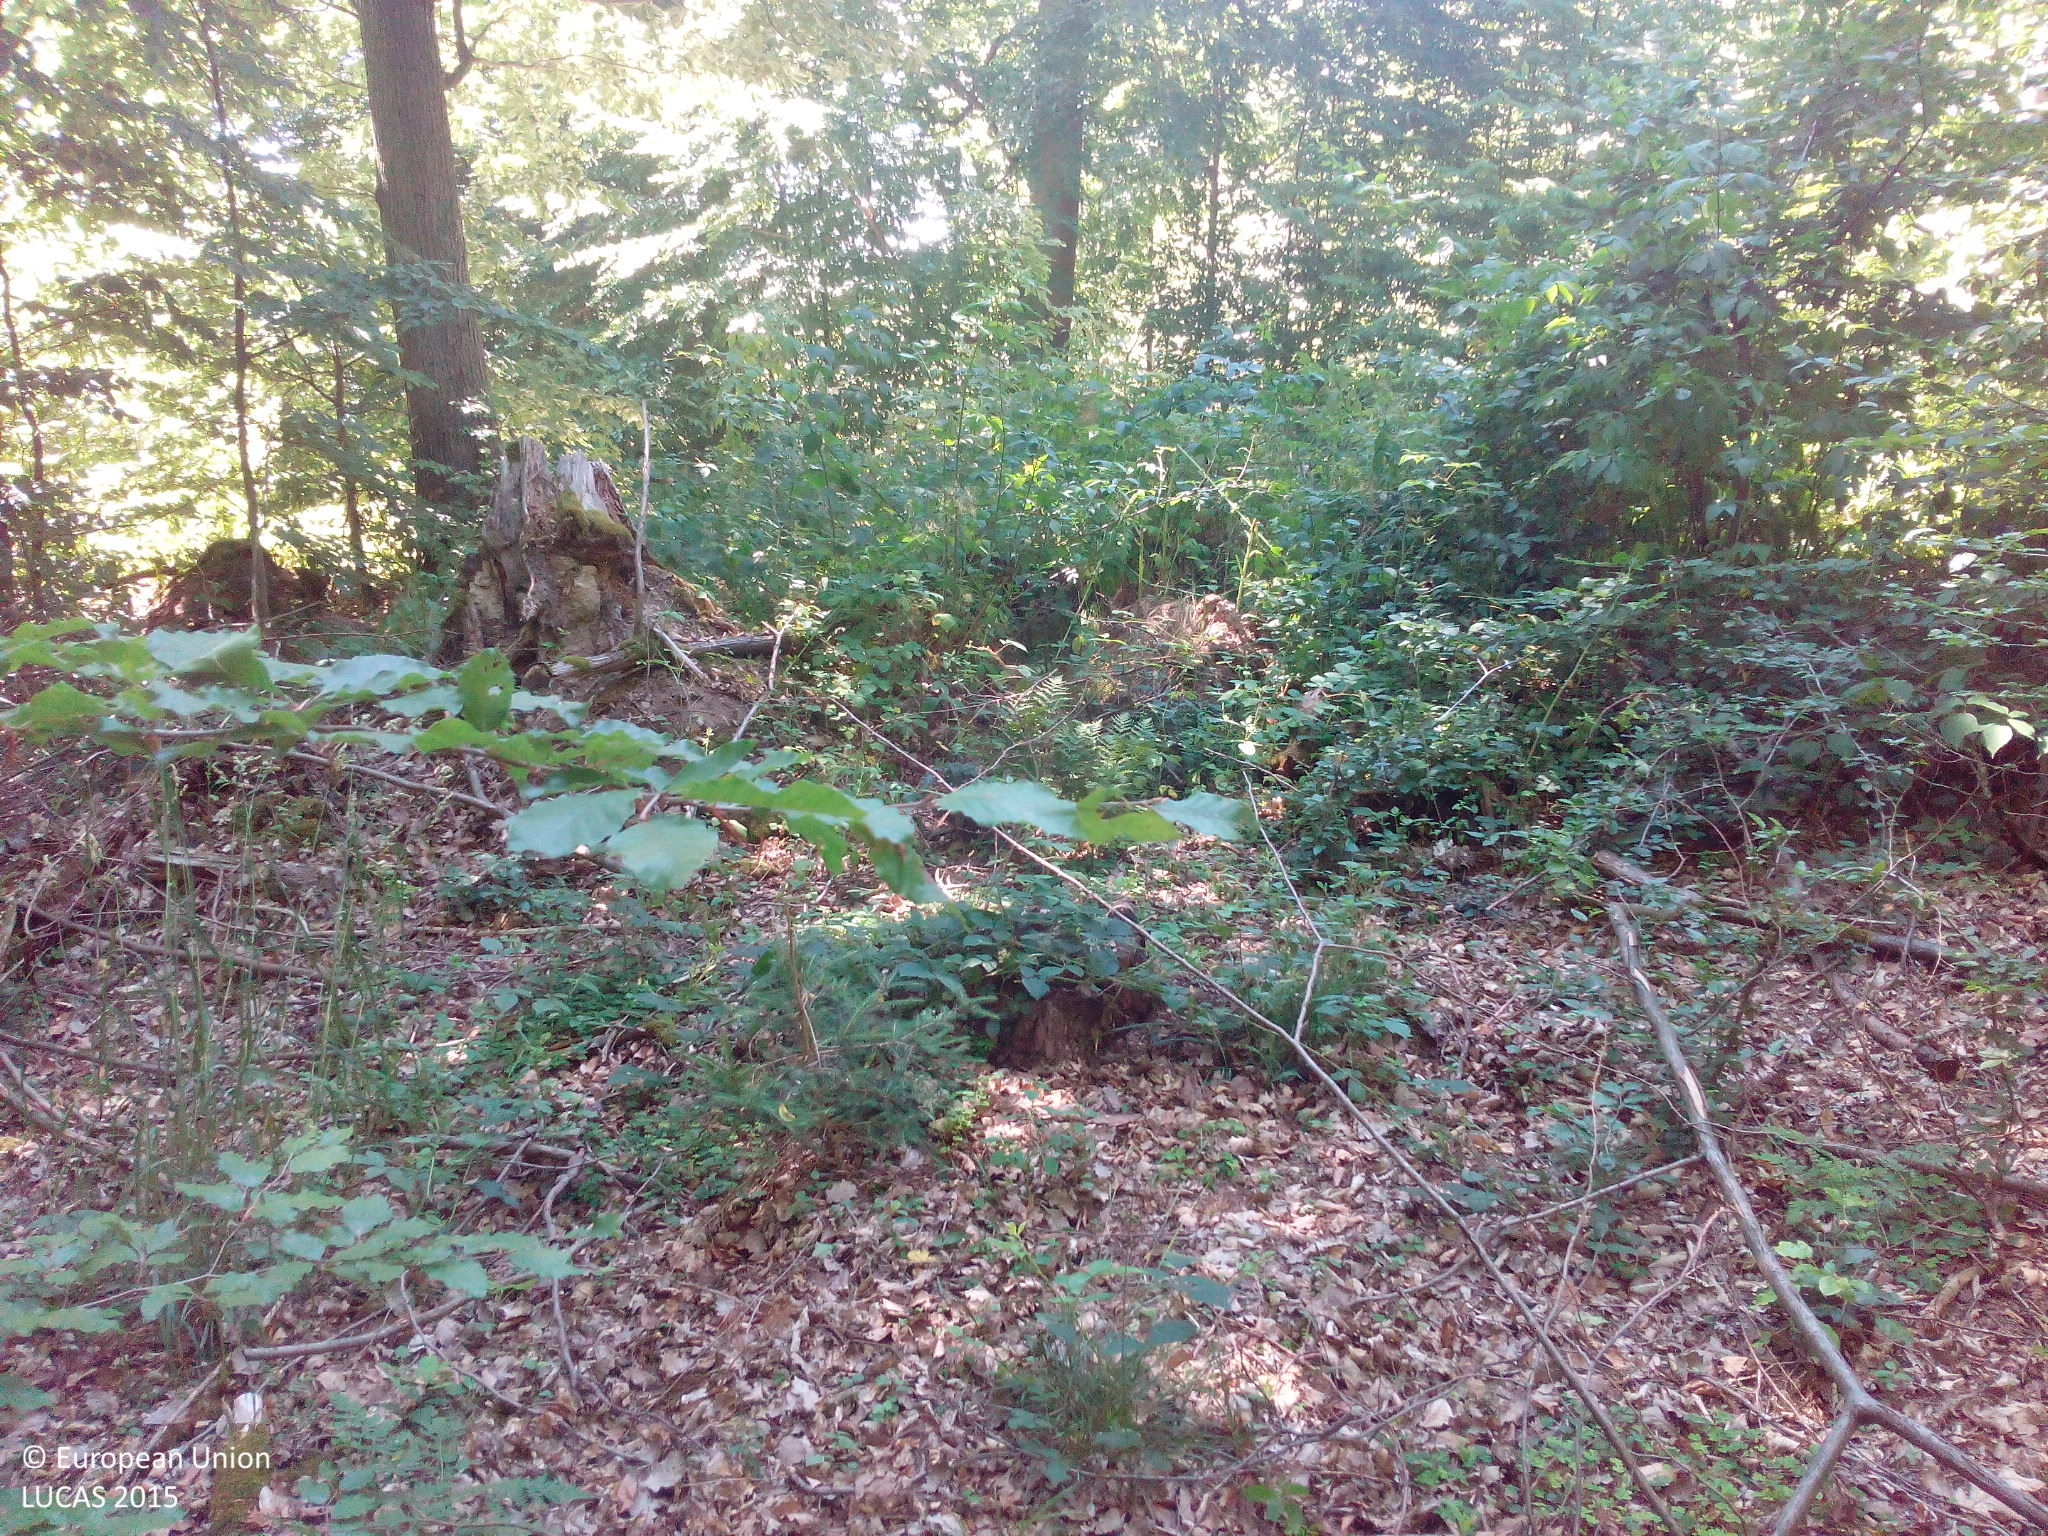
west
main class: Woodland
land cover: Pine dominated mixed woodland
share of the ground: 50 - 75 %
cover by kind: broadleaved forest trees 30 %, coniferous forest trees 25 %, unconsolidated bare surface 25 %, shrubs 20 %
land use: Forestry
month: July
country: DE
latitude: 49.6253
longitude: 10.5674
